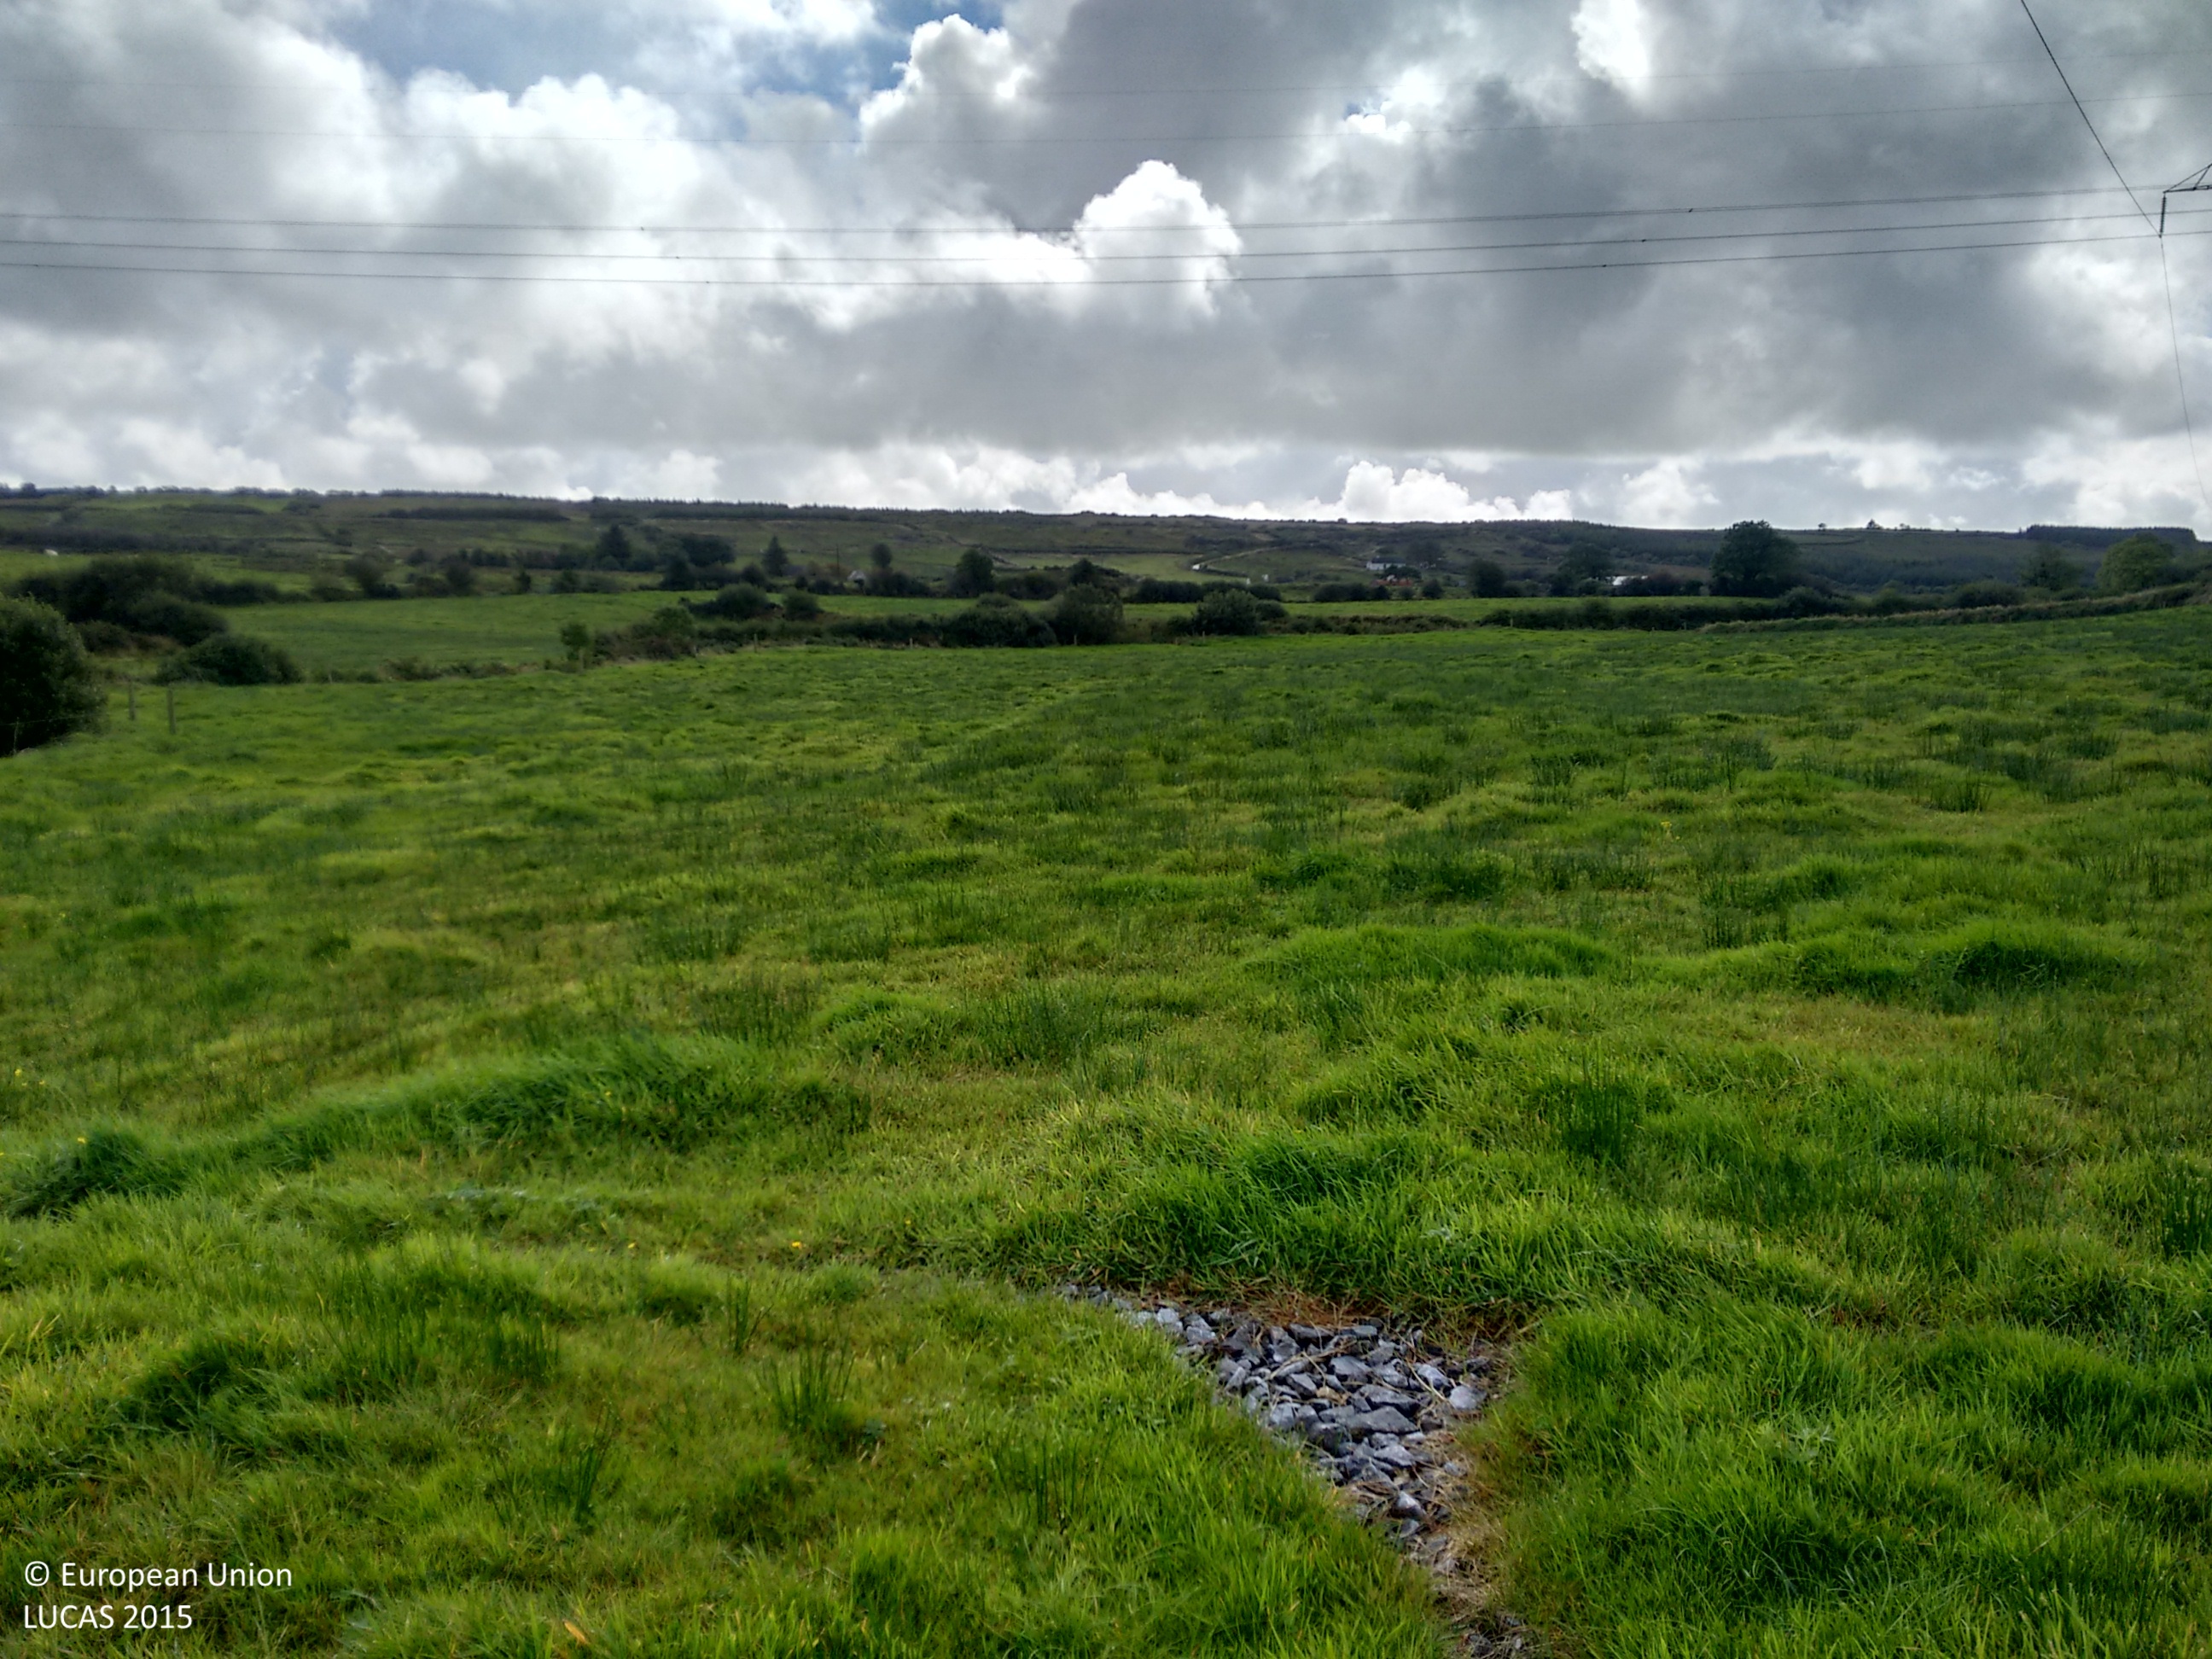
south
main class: Grassland
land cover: Grassland without tree/shrub cover
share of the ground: > 75 %
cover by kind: herbaceous plants 95 %, unconsolidated bare surface 5 %
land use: Agriculture (excluding fallow land and kitchen gardens)
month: September
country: IE
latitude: 52.7162
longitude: -9.1837
